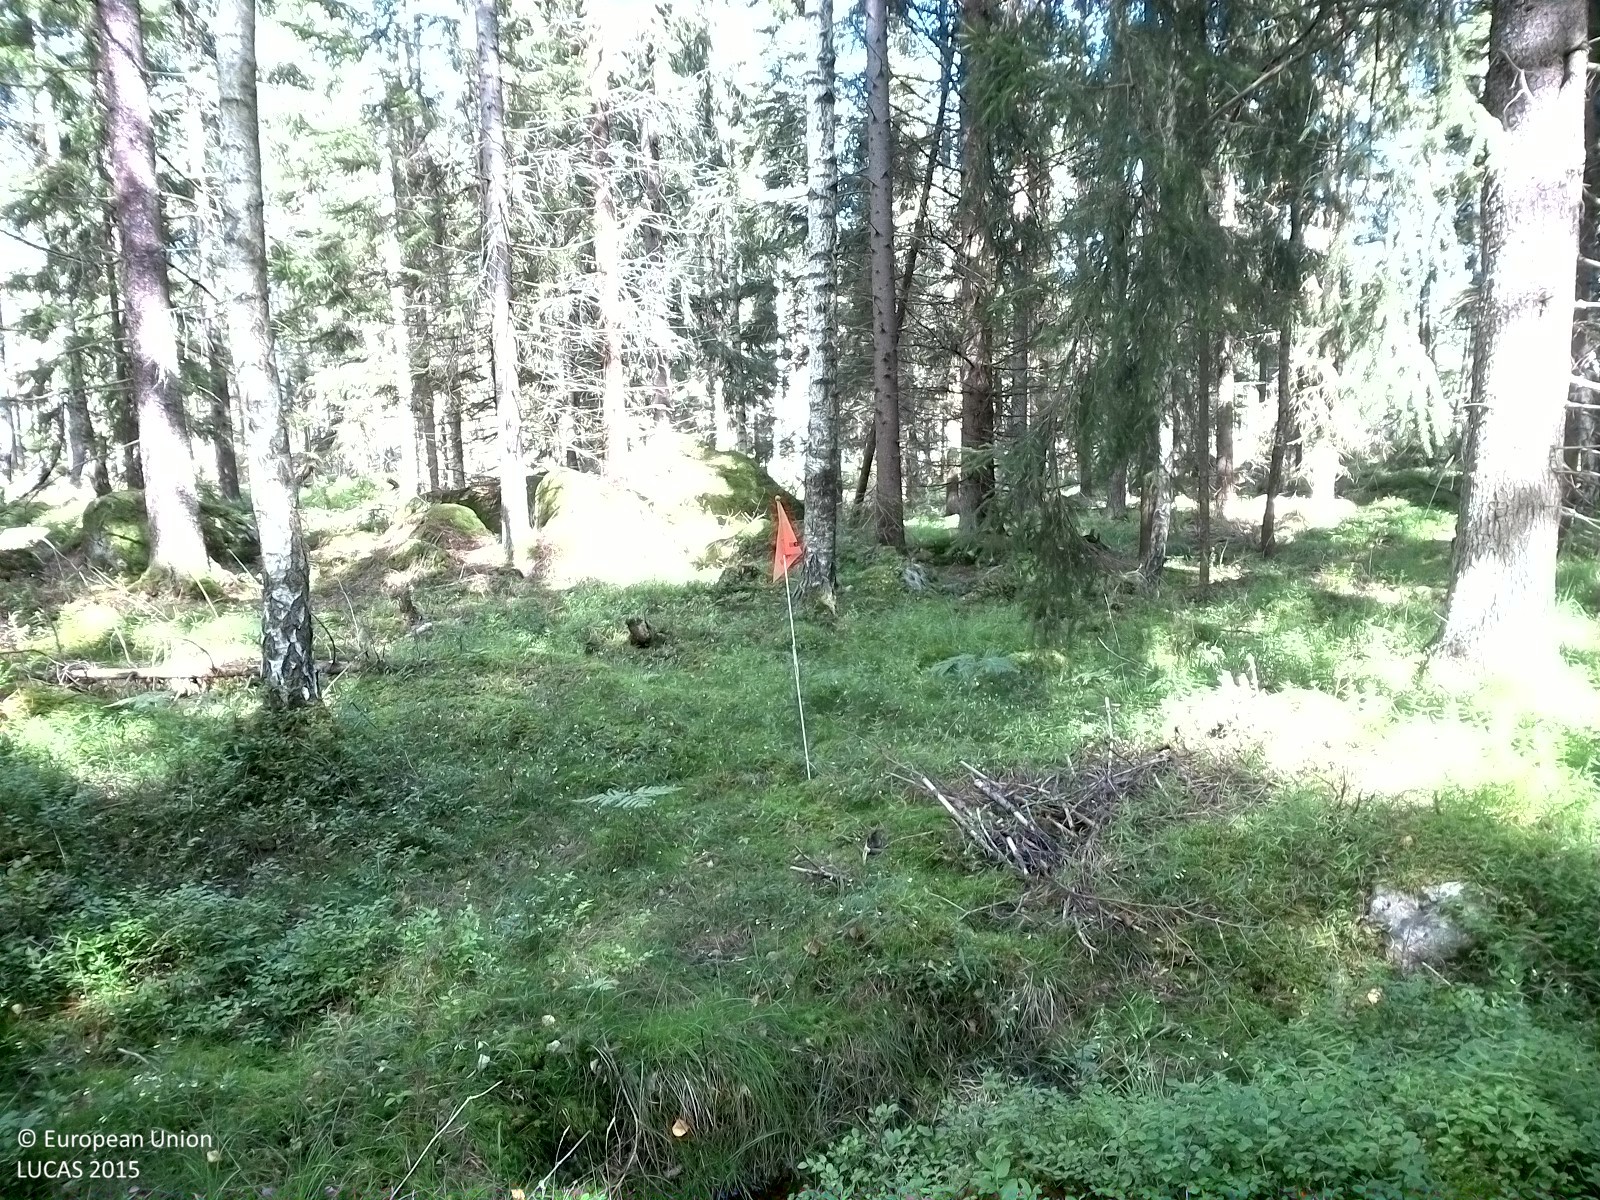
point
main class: Woodland
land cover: Spruce dominated mixed woodland
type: boreal forest
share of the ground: 25 - 50 %
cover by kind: herbaceous plants 35 %, coniferous forest trees 30 %, broadleaved forest trees 15 %, lichens and mosses 15 %, shrubs 5 %
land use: Forestry
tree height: > 5 m
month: August
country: SE
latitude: 59.0424
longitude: 15.0989
